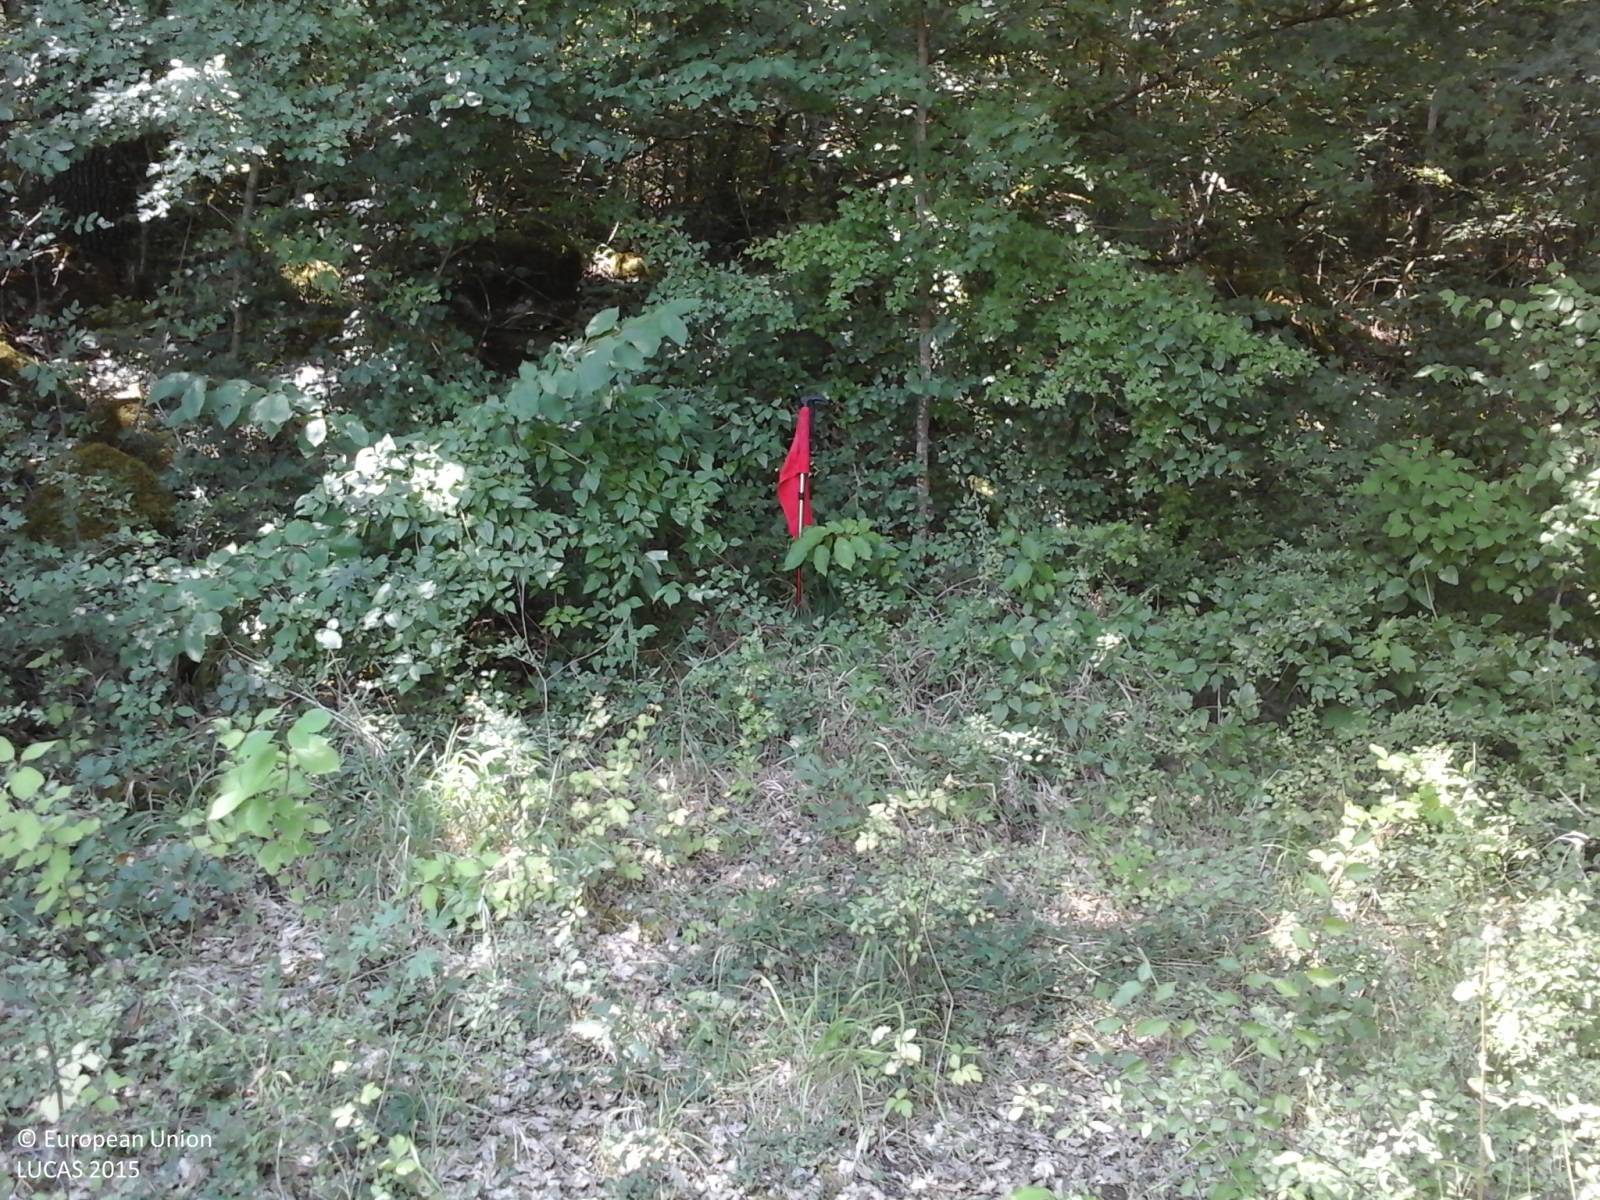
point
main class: Woodland
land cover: Broadleaved woodland
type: thermophilous deciduous forest
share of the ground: > 75 %
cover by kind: broadleaved forest trees 100 %
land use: Semi-natural and natural areas not in use
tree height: > 5 m
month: July
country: IT
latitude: 42.3275
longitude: 13.3506
